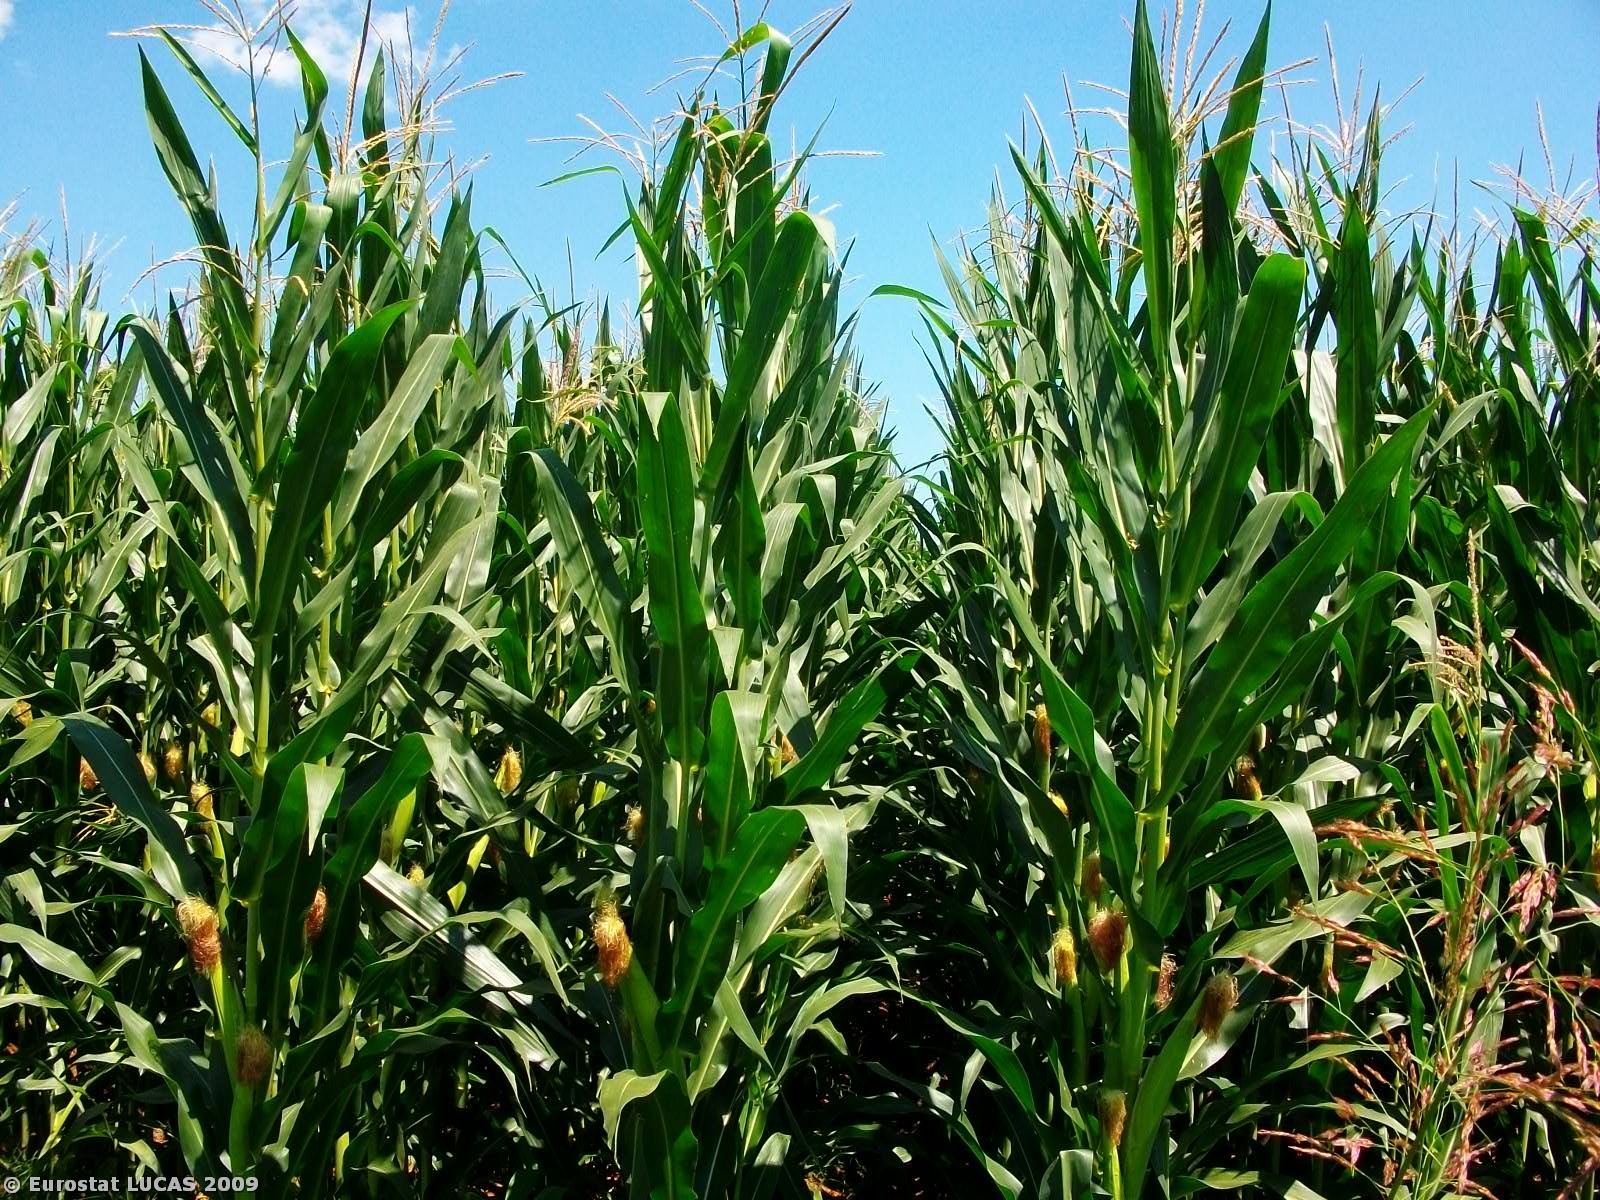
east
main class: Cropland
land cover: Maize
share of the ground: > 75 %
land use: Agriculture (excluding fallow land and kitchen gardens)
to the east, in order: Maize; Broadleaved woodland; Spontaneously vegetated surfaces; Maize; Broadleaved woodland; Maize; Broadleaved woodland
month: July
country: GR
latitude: 41.2582
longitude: 23.1817
